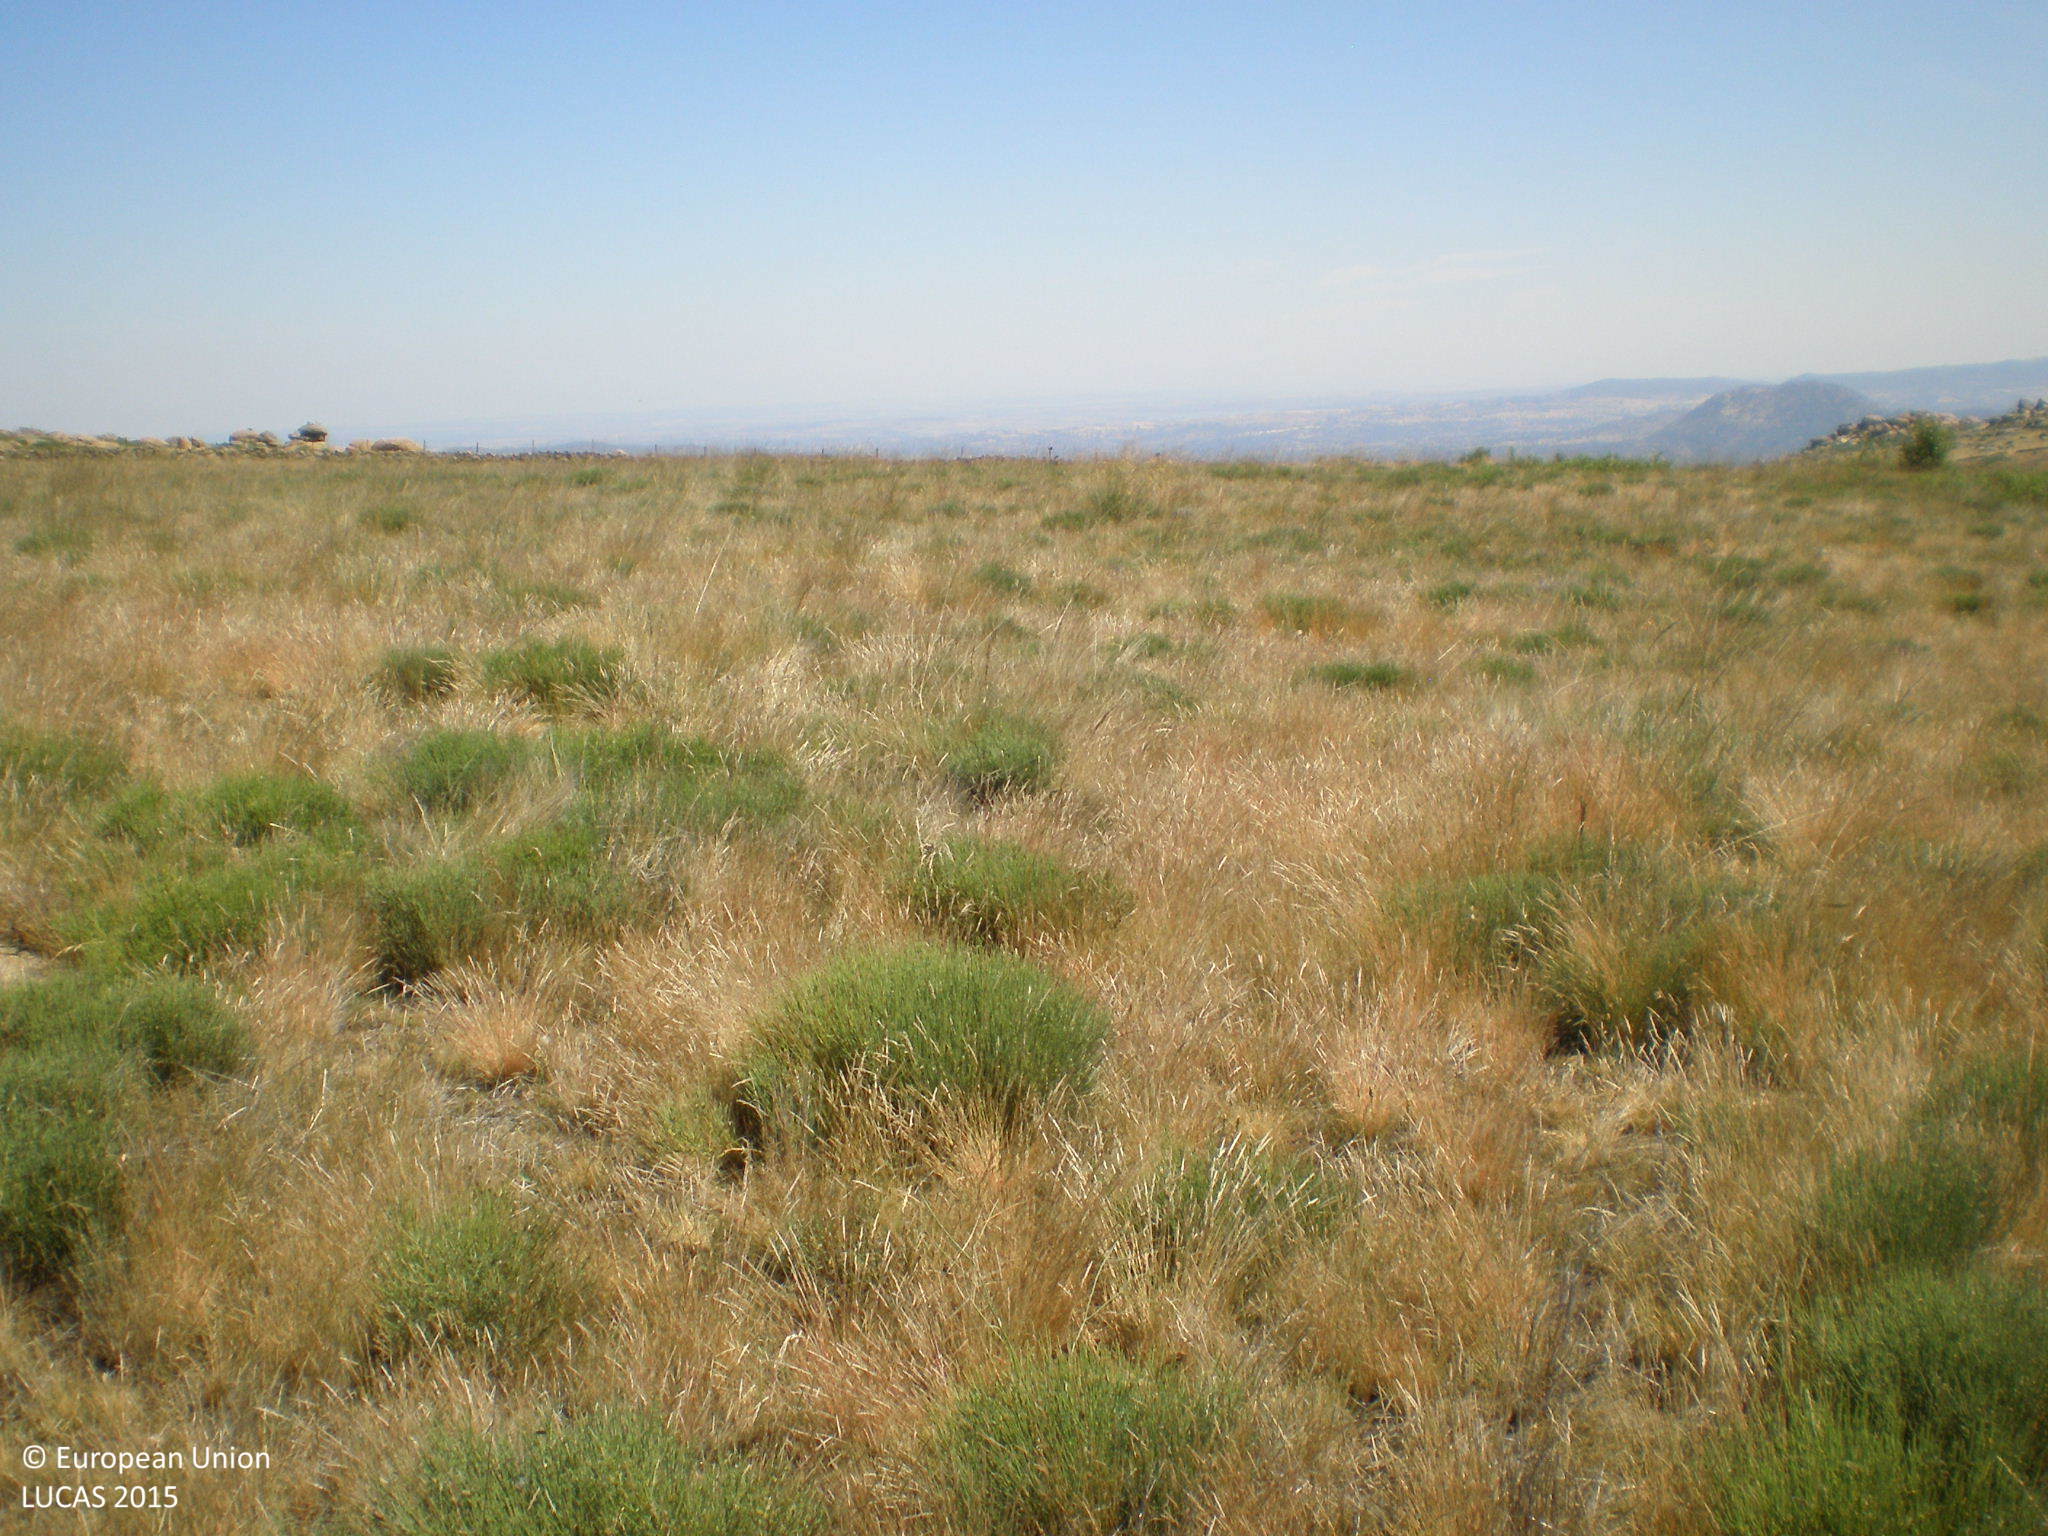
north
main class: Grassland
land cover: Grassland without tree/shrub cover
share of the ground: > 75 %
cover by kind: herbaceous plants 100 %
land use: Agriculture (excluding fallow land and kitchen gardens)
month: June
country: ES
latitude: 40.3710
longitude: -5.6015
